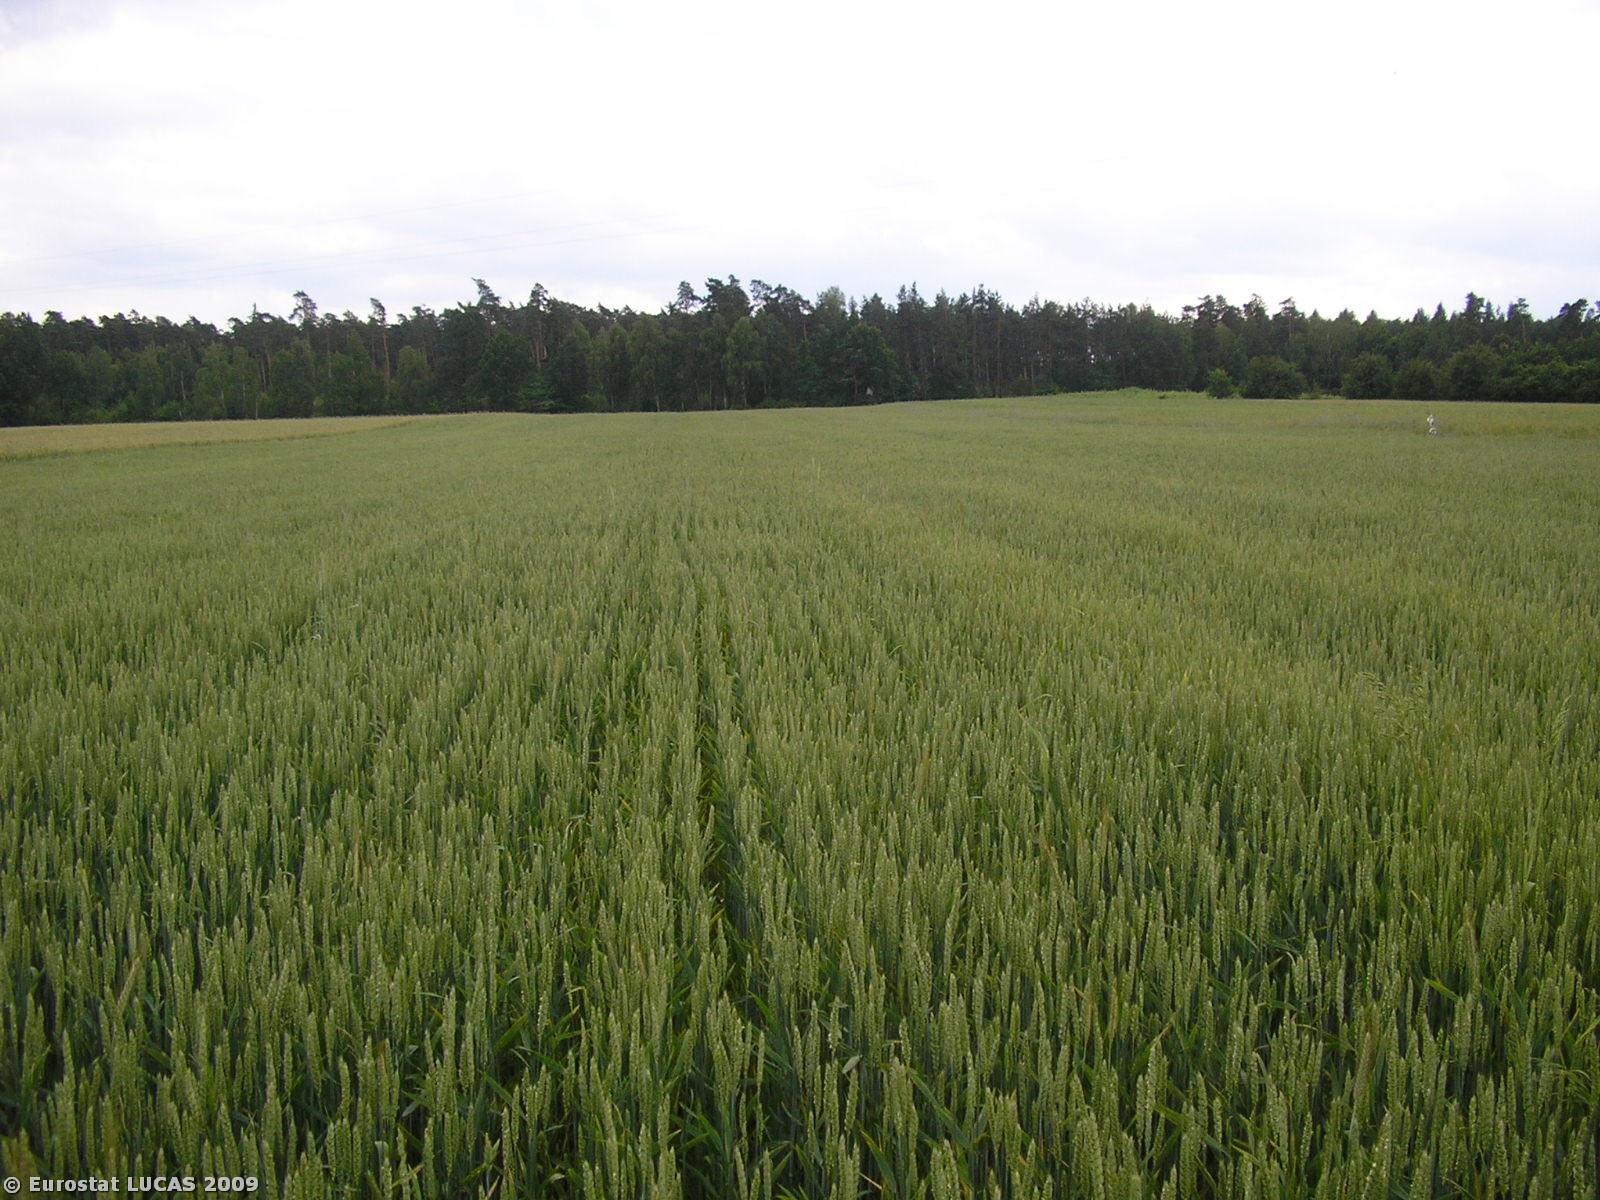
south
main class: Cropland
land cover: Common wheat
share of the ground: > 75 %
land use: Agriculture (excluding fallow land and kitchen gardens)
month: June
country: PL
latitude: 51.0736
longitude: 18.3103
